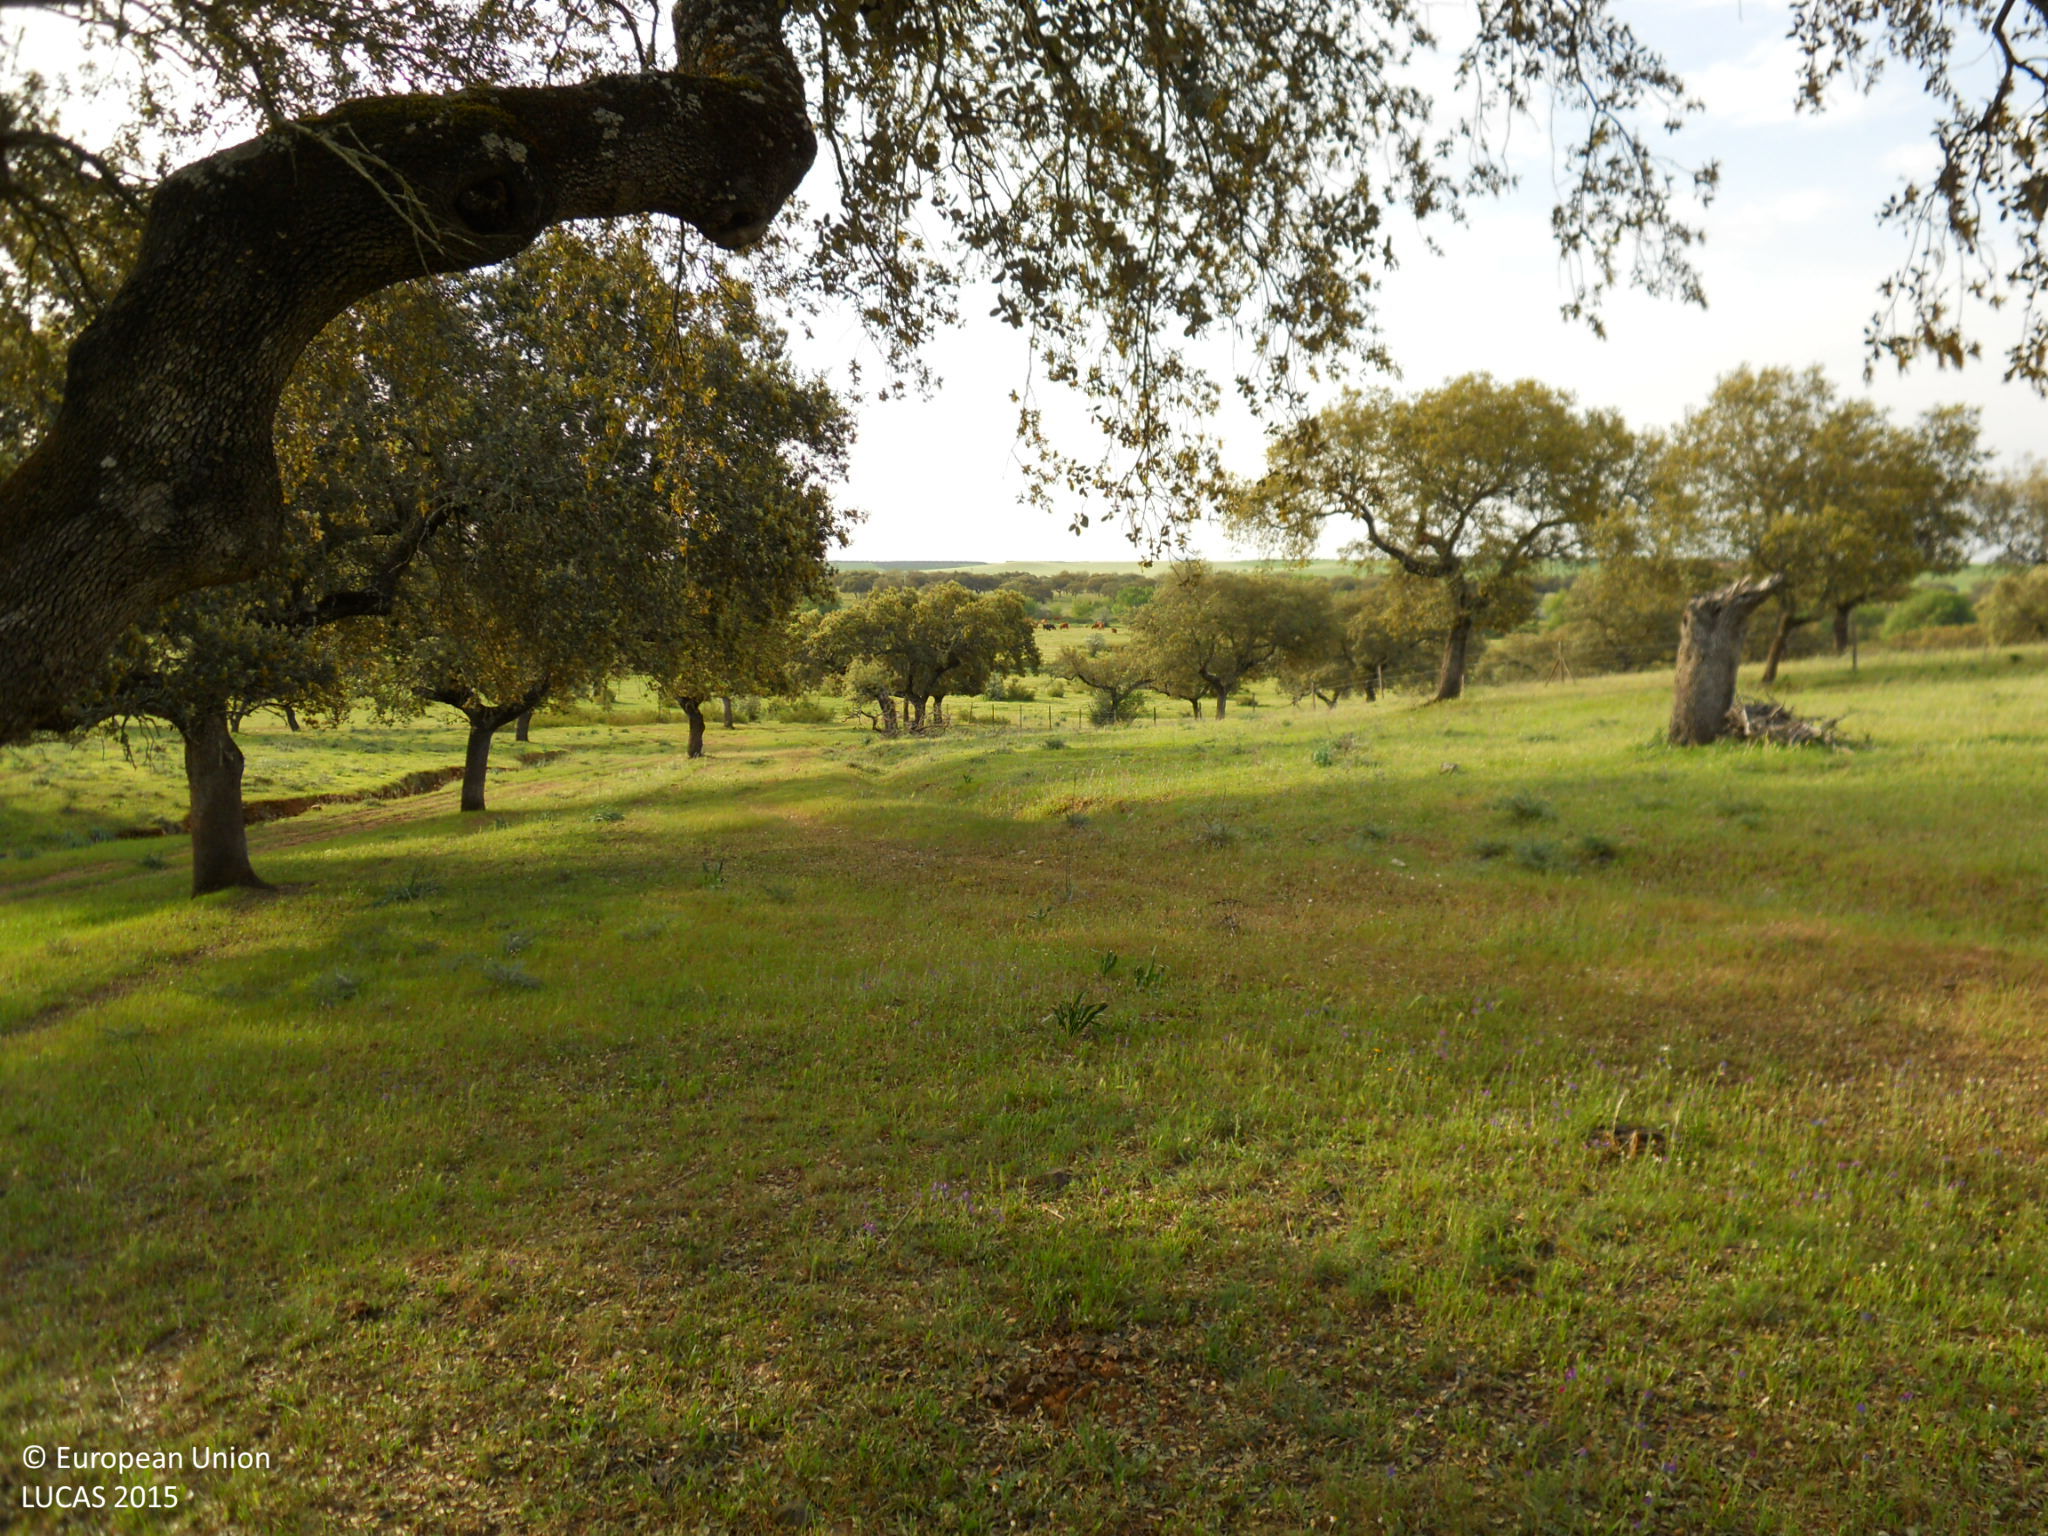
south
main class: Woodland
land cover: Broadleaved woodland
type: broadleaved evergreen forest
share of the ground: 50 - 75 %
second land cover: Grassland without tree/shrub cover
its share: > 75 %
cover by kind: broadleaved forest trees 50 %, herbaceous plants 50 %
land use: Forestry
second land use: Agriculture (excluding fallow land and kitchen gardens)
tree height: > 5 m
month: April
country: ES
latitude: 39.0744
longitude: -6.5356
